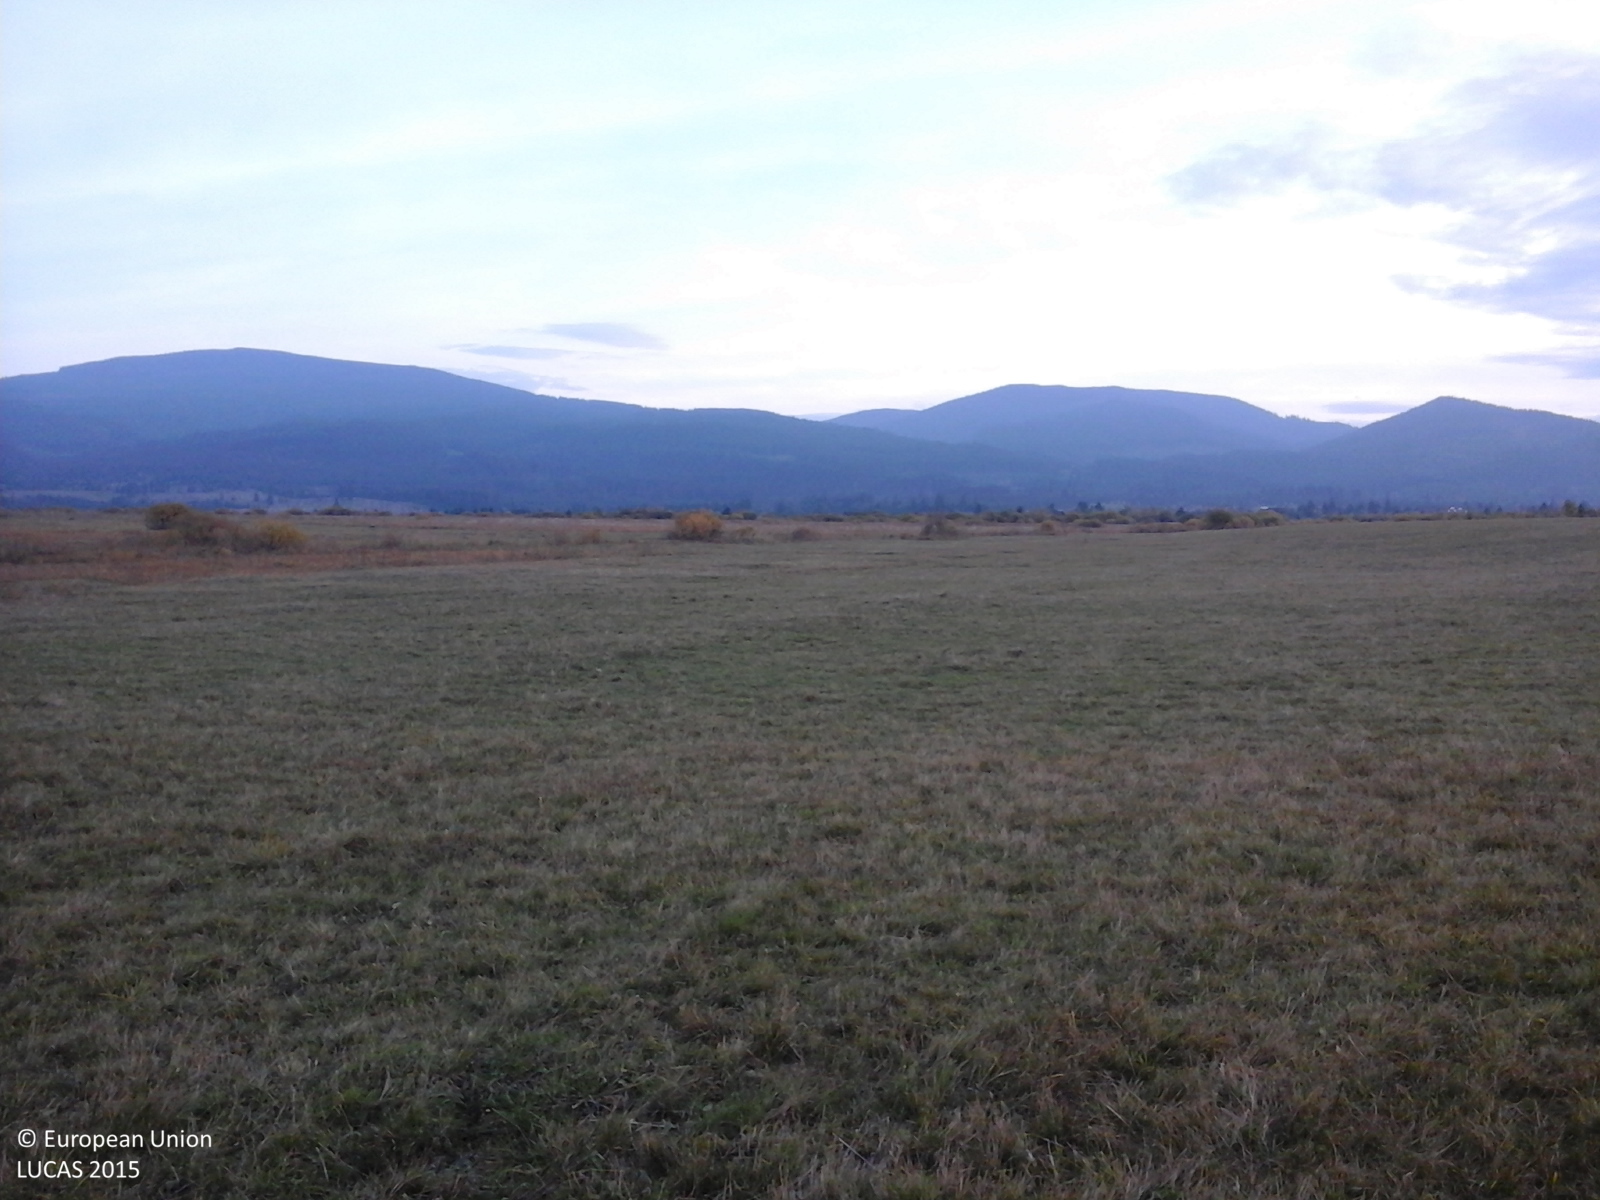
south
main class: Grassland
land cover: Grassland without tree/shrub cover
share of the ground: > 75 %
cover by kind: herbaceous plants 100 %
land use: Agriculture (excluding fallow land and kitchen gardens)
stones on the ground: < 10 %
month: October
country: RO
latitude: 46.6691
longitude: 25.4407
